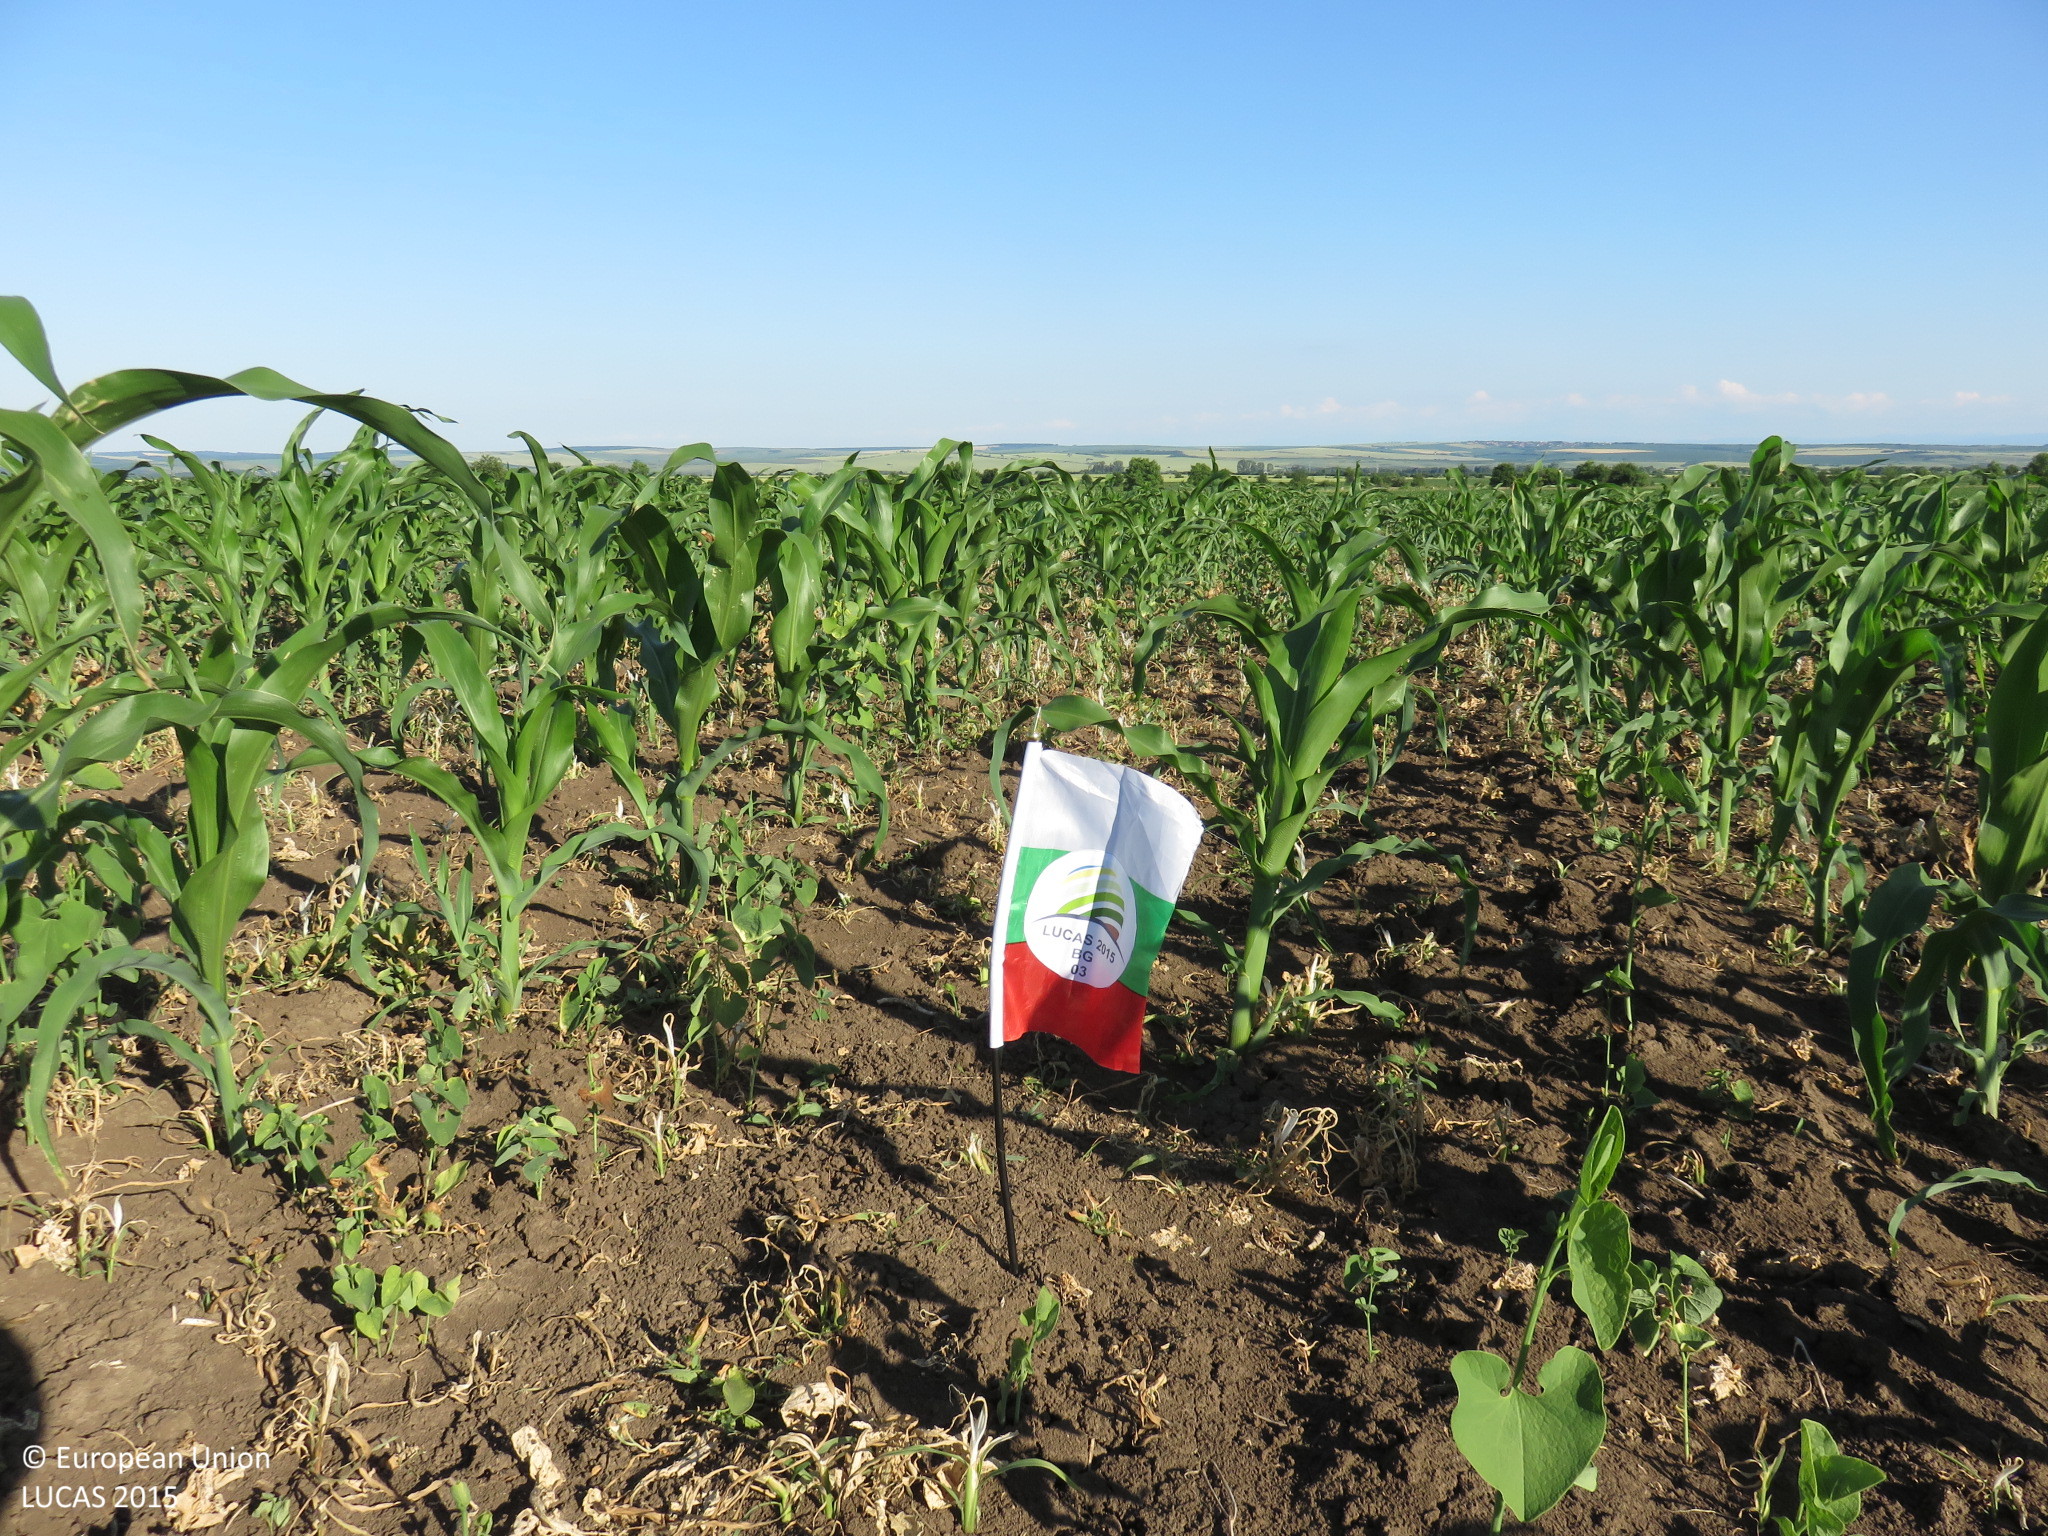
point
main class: Cropland
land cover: Maize
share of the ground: > 75 %
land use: Agriculture (excluding fallow land and kitchen gardens)
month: June
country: BG
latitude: 43.3783
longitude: 24.3883
